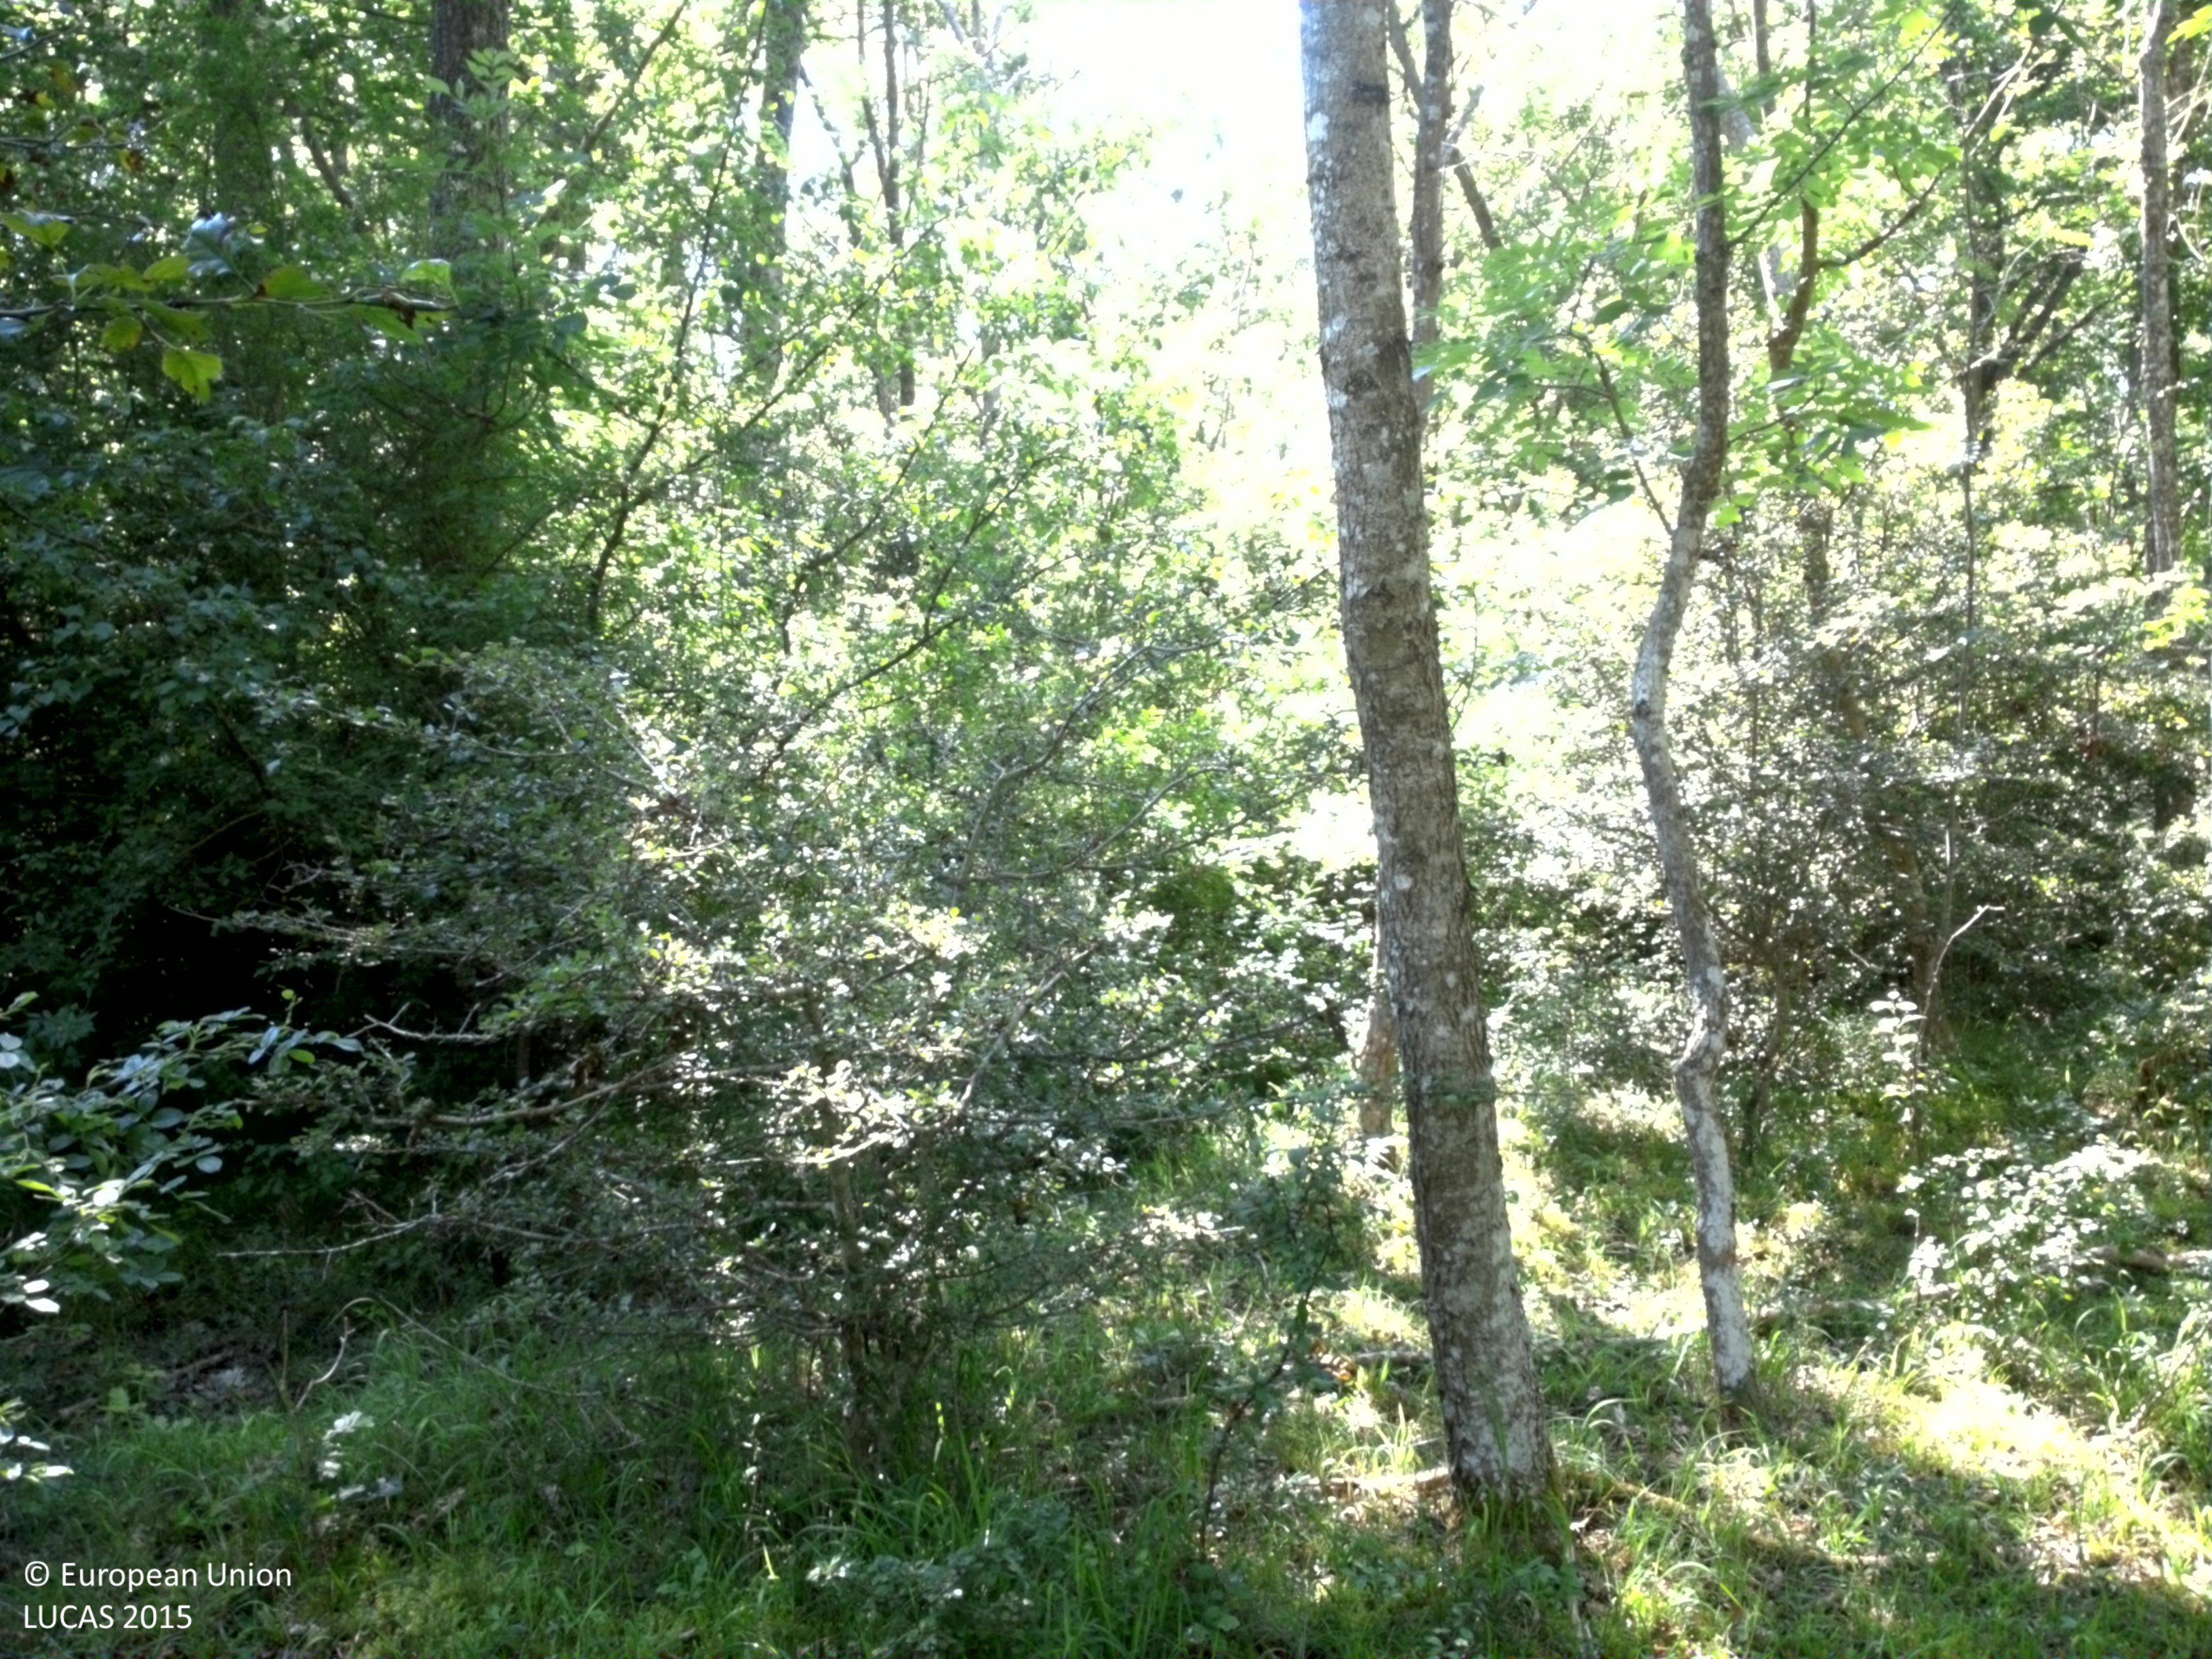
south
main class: Woodland
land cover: Broadleaved woodland
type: mesophytic deciduous forest
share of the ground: > 75 %
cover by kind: broadleaved forest trees 80 %, shrubs 10 %, herbaceous plants 10 %
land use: Forestry
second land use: Agriculture (excluding fallow land and kitchen gardens)
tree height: > 5 m
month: July
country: SE
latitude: 57.1890
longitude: 18.2317
